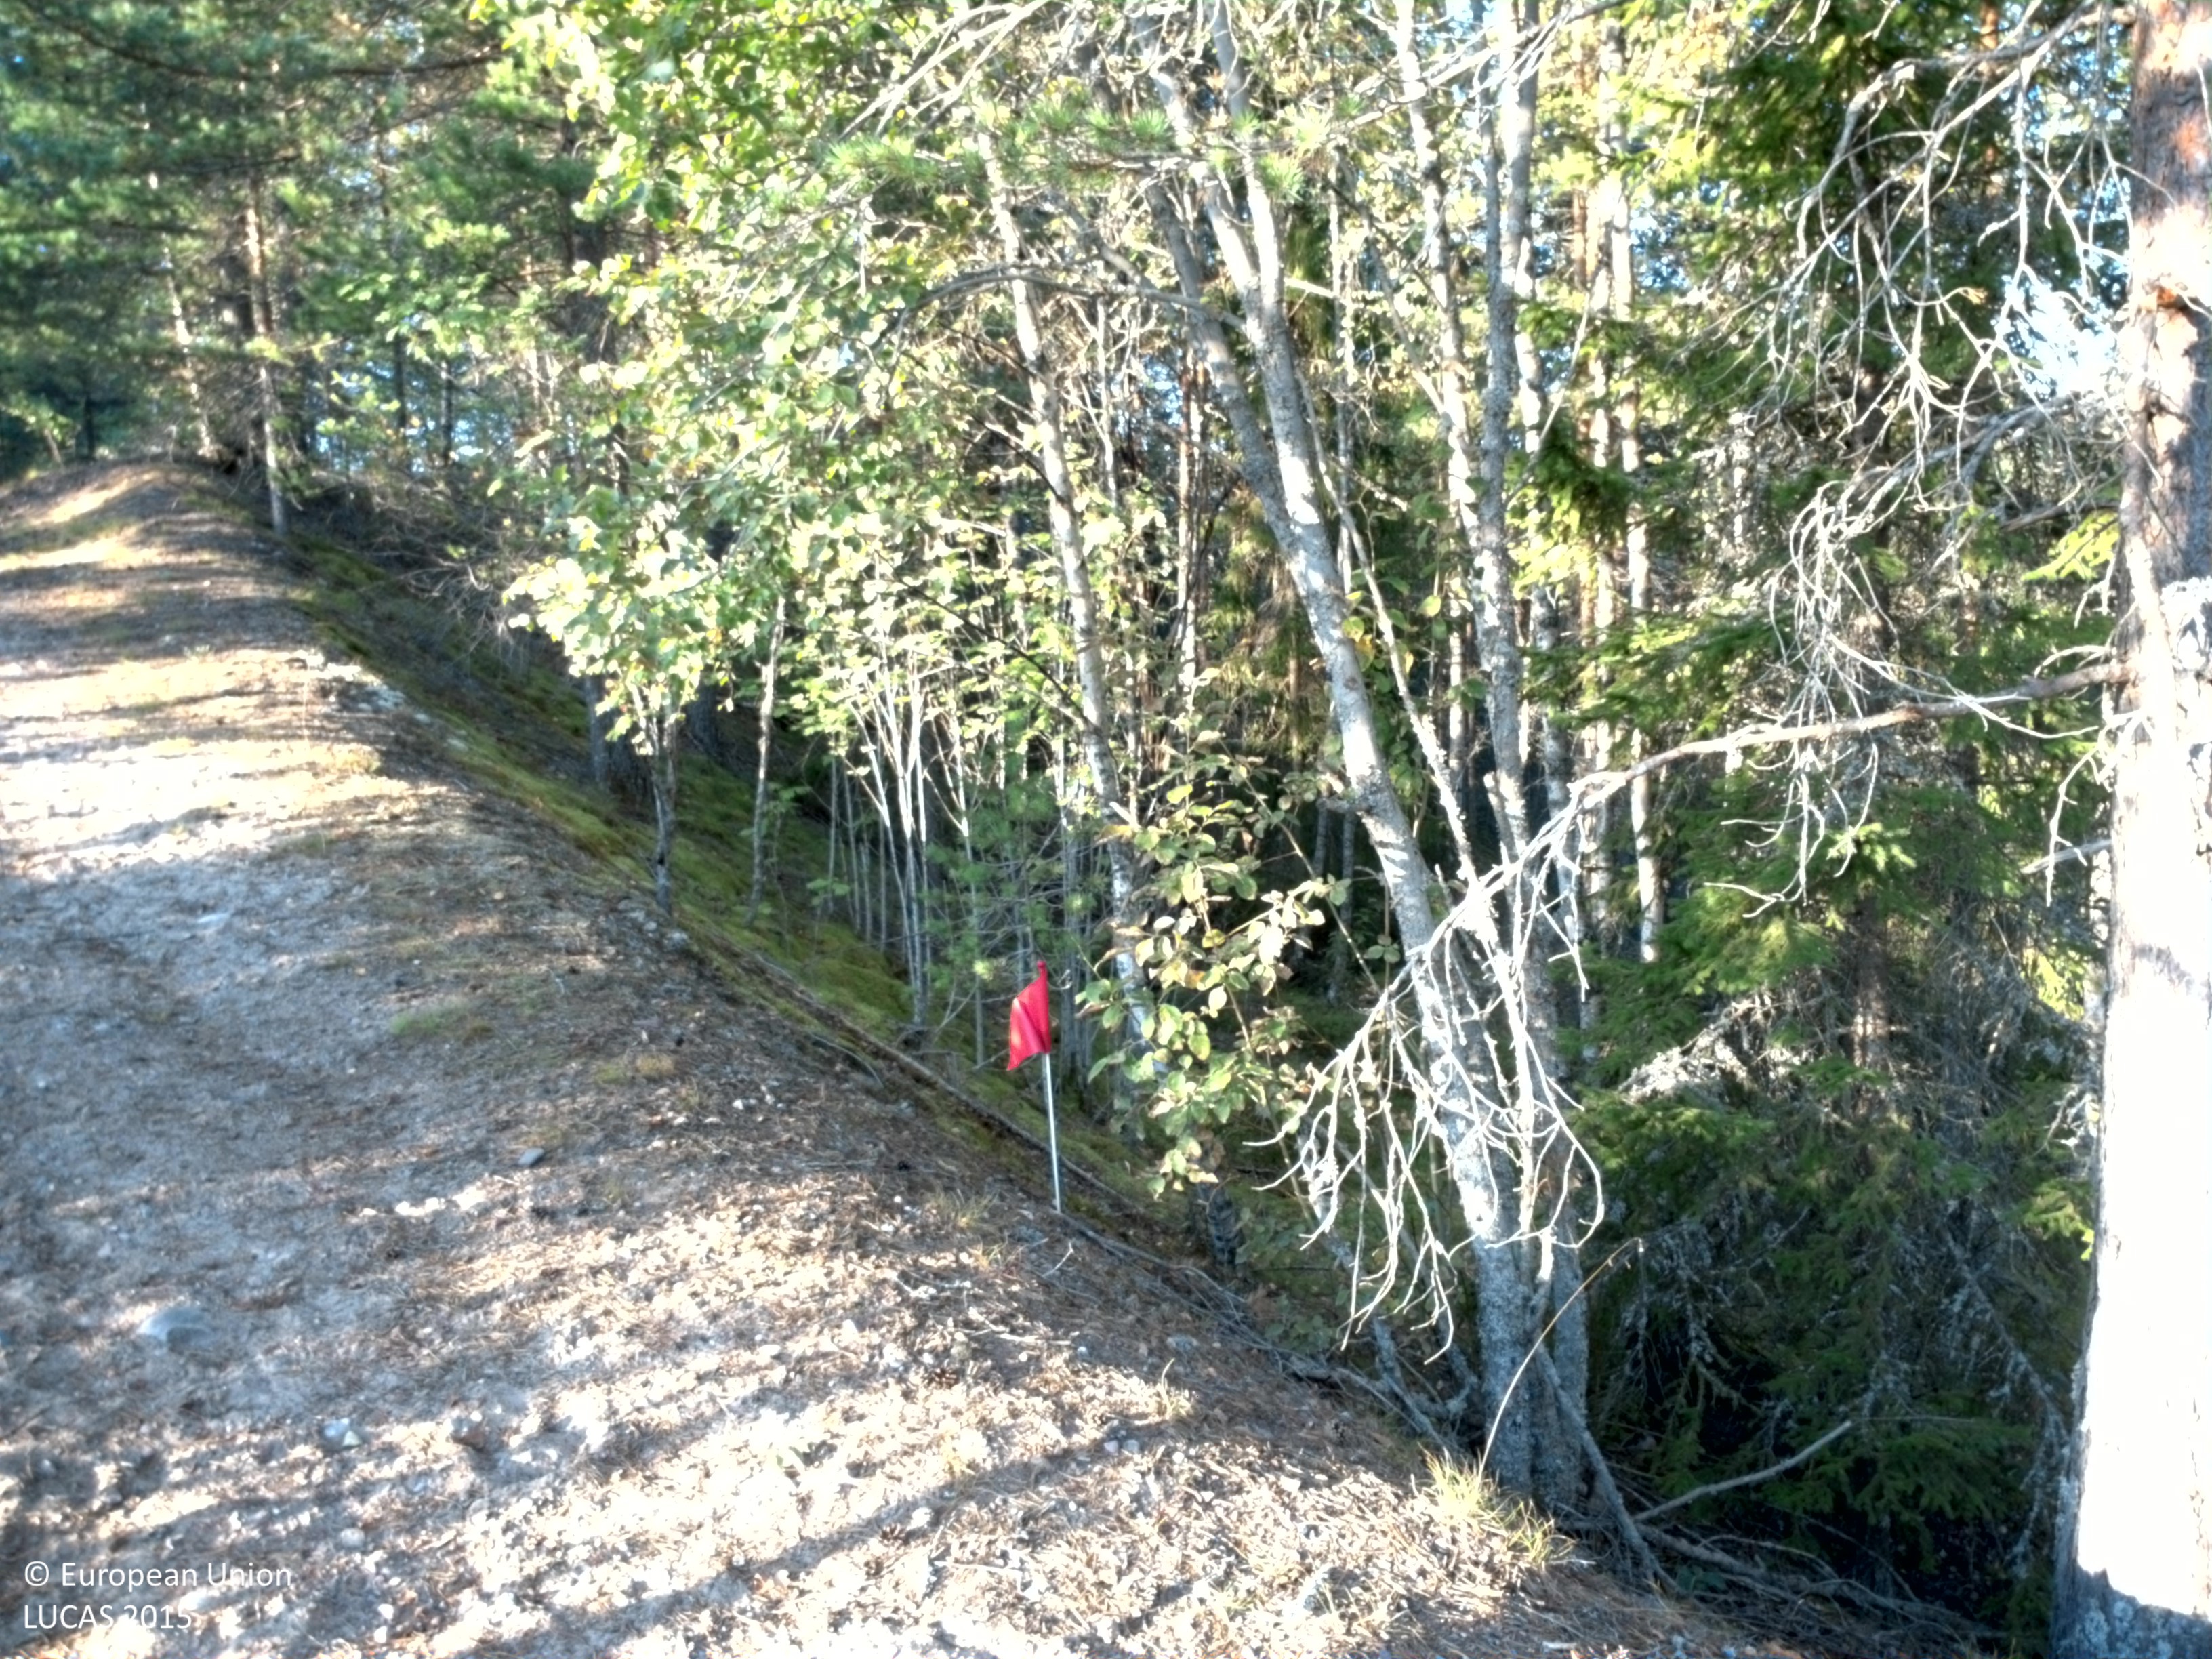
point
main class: Woodland
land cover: Pine dominated mixed woodland
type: boreal forest
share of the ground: 25 - 50 %
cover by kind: coniferous forest trees 35 %, lichens and mosses 25 %, consolidated bare surface 20 %, broadleaved forest trees 15 %, herbaceous plants 5 %
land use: Sport
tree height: > 5 m
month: August
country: SE
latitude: 59.5288
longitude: 13.3335
